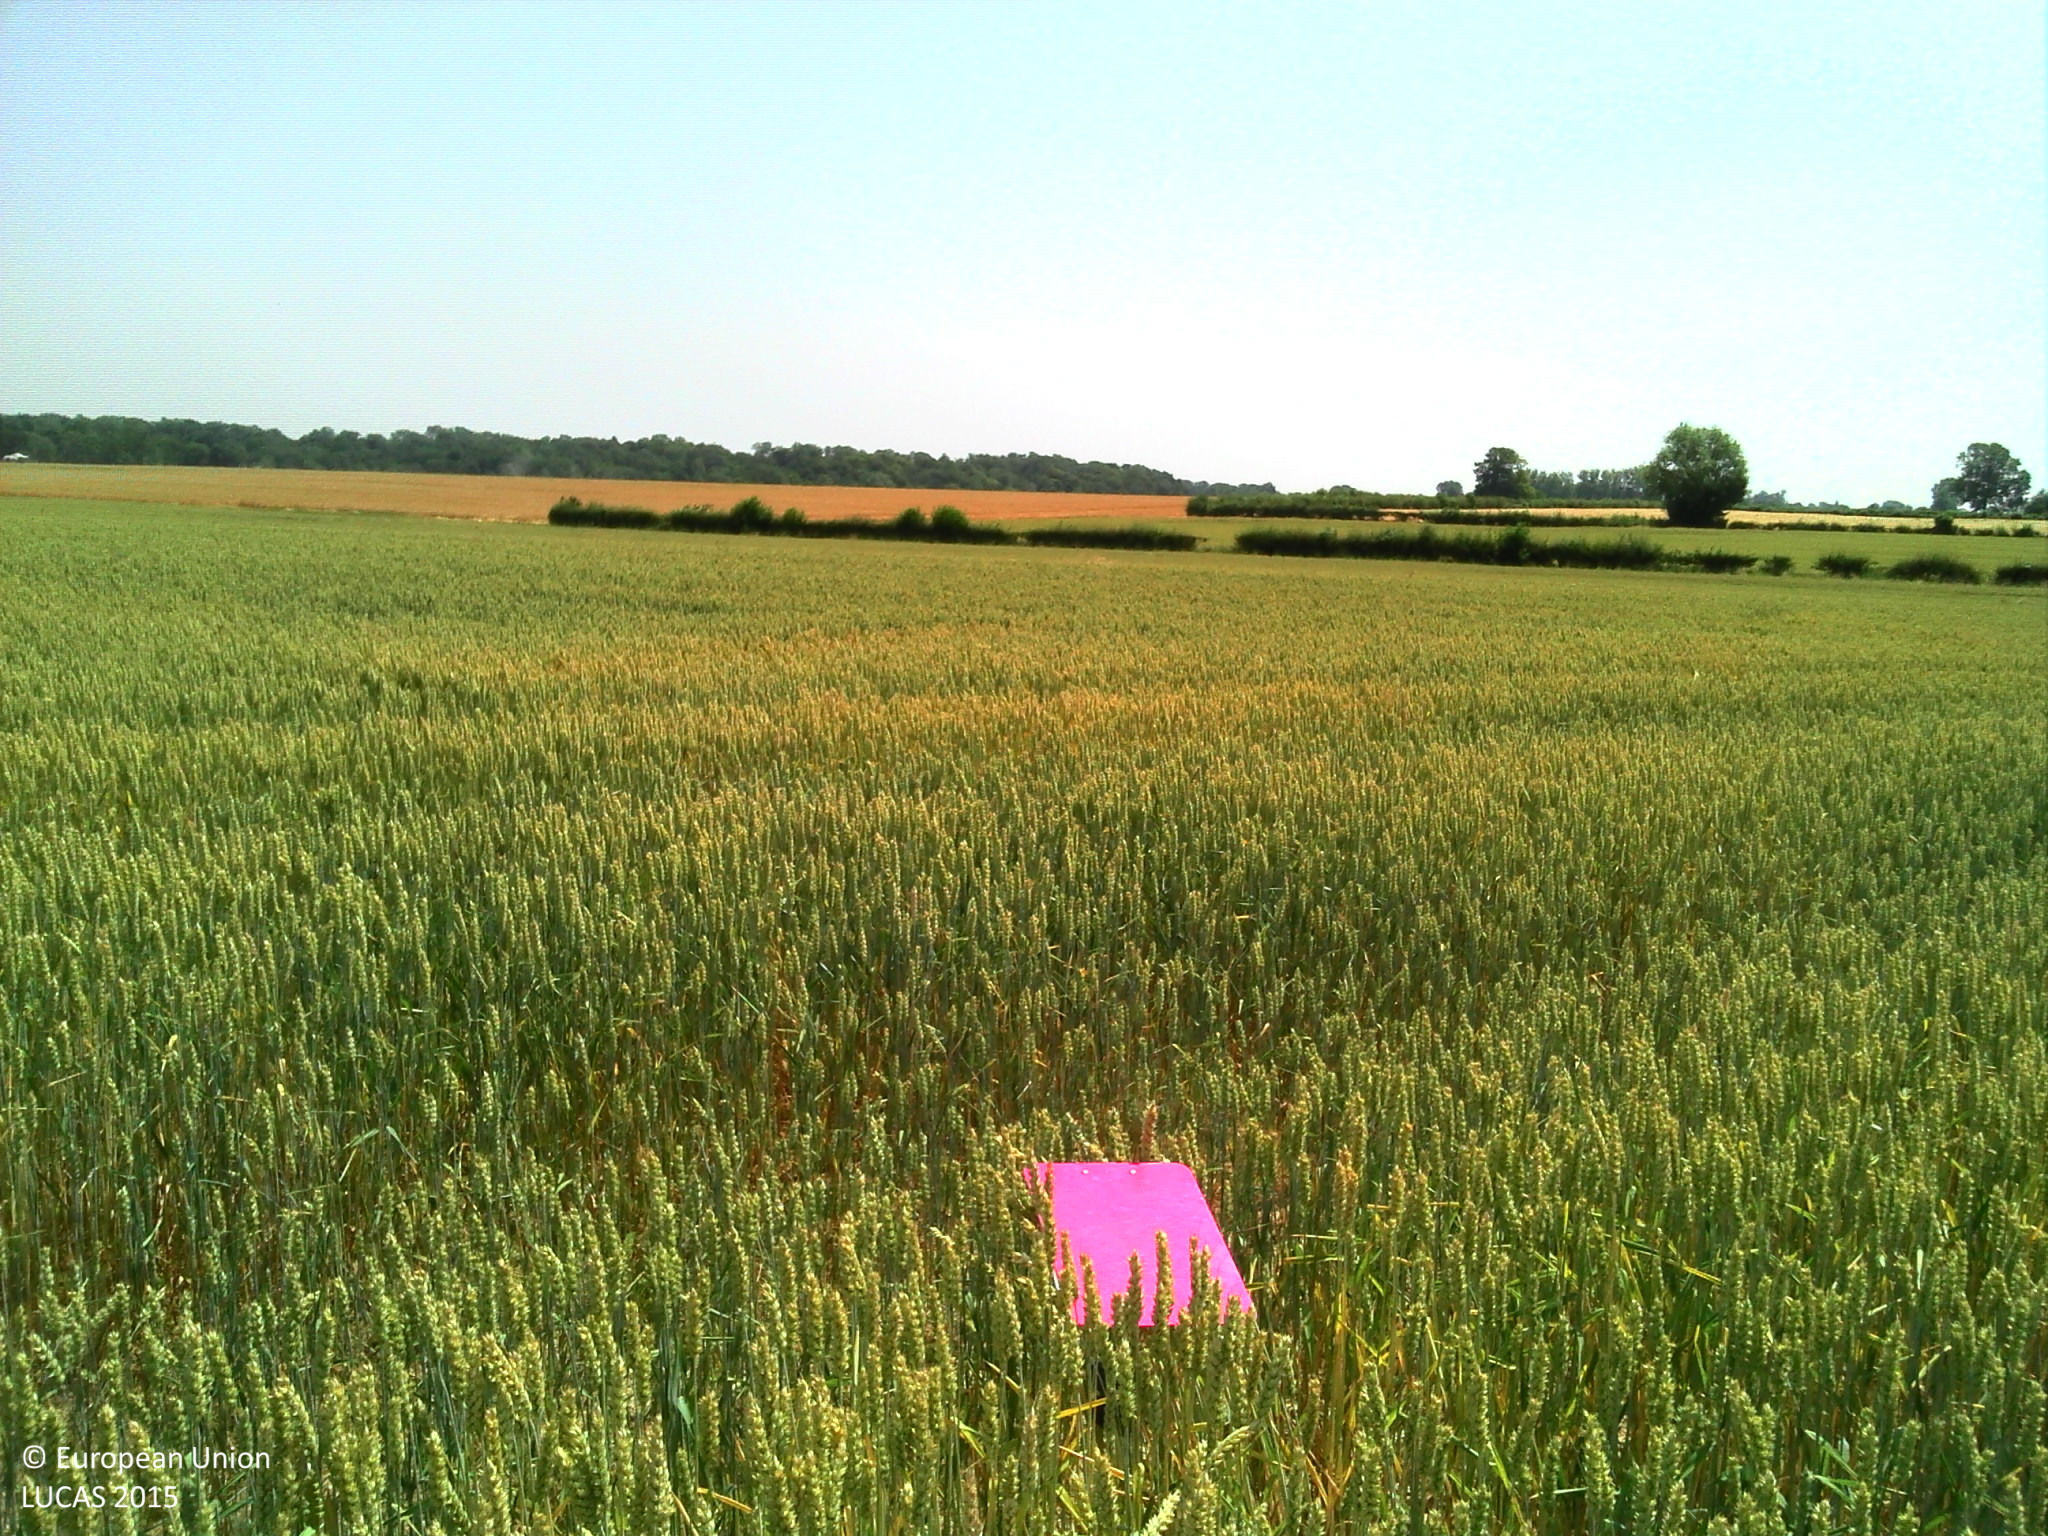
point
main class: Cropland
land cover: Common wheat
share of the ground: > 75 %
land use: Agriculture (excluding fallow land and kitchen gardens)
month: July
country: FR
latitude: 49.7049
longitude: 1.7606
